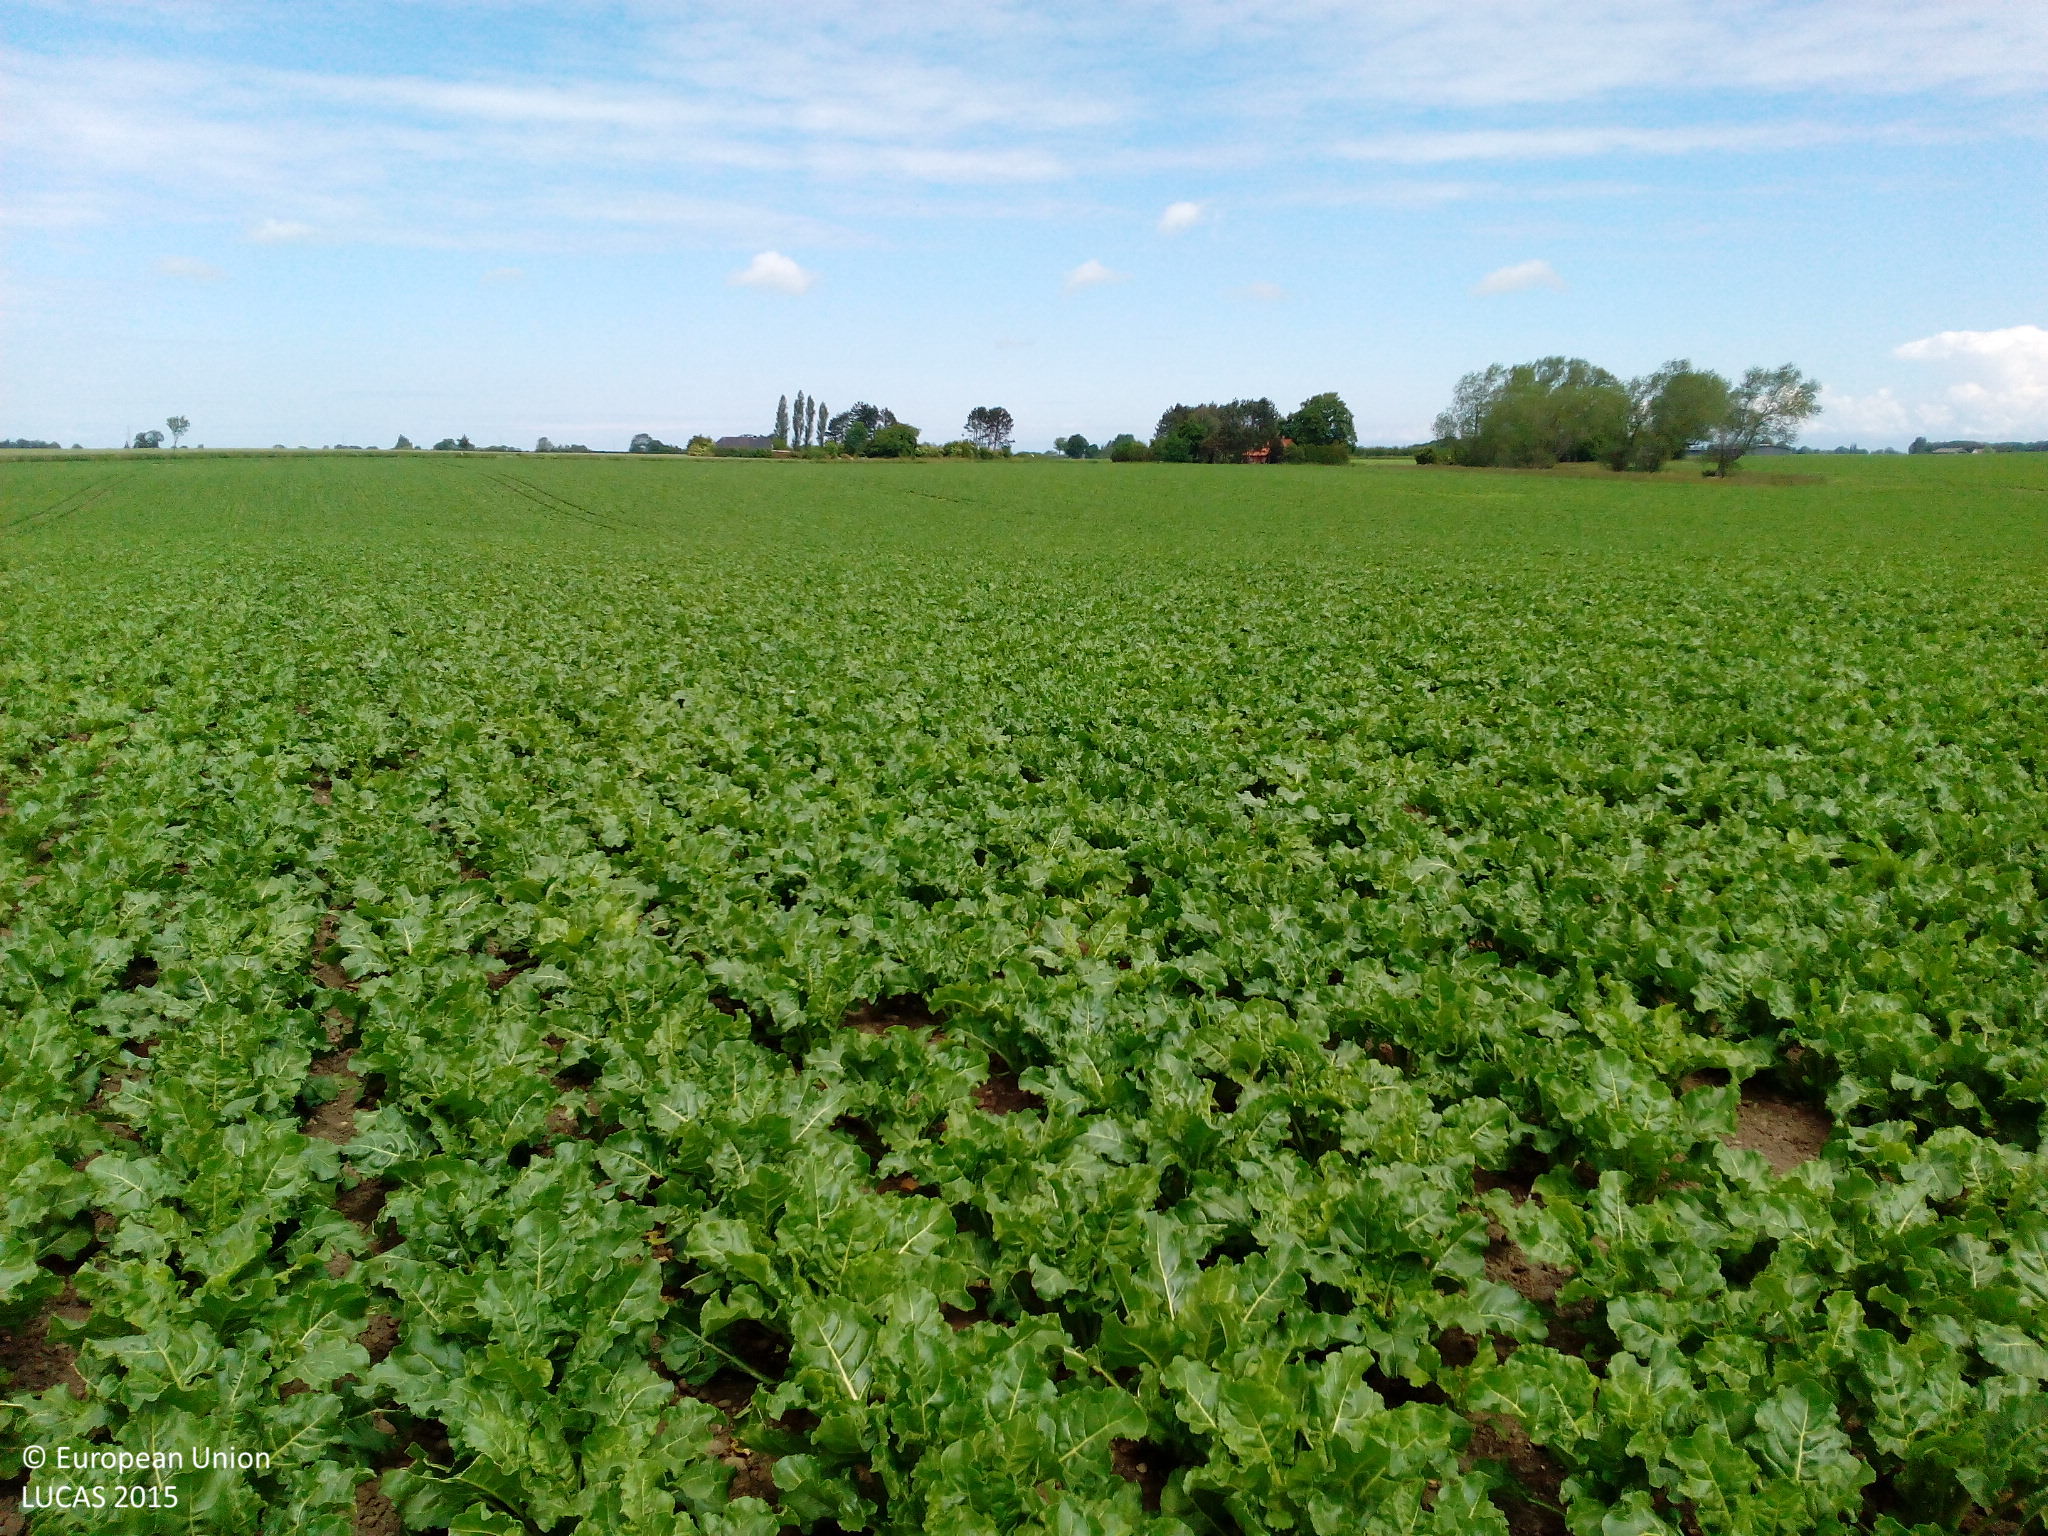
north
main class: Cropland
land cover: Sugar beet
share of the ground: > 75 %
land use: Agriculture (excluding fallow land and kitchen gardens)
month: June
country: DK
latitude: 54.8516
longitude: 11.2296
